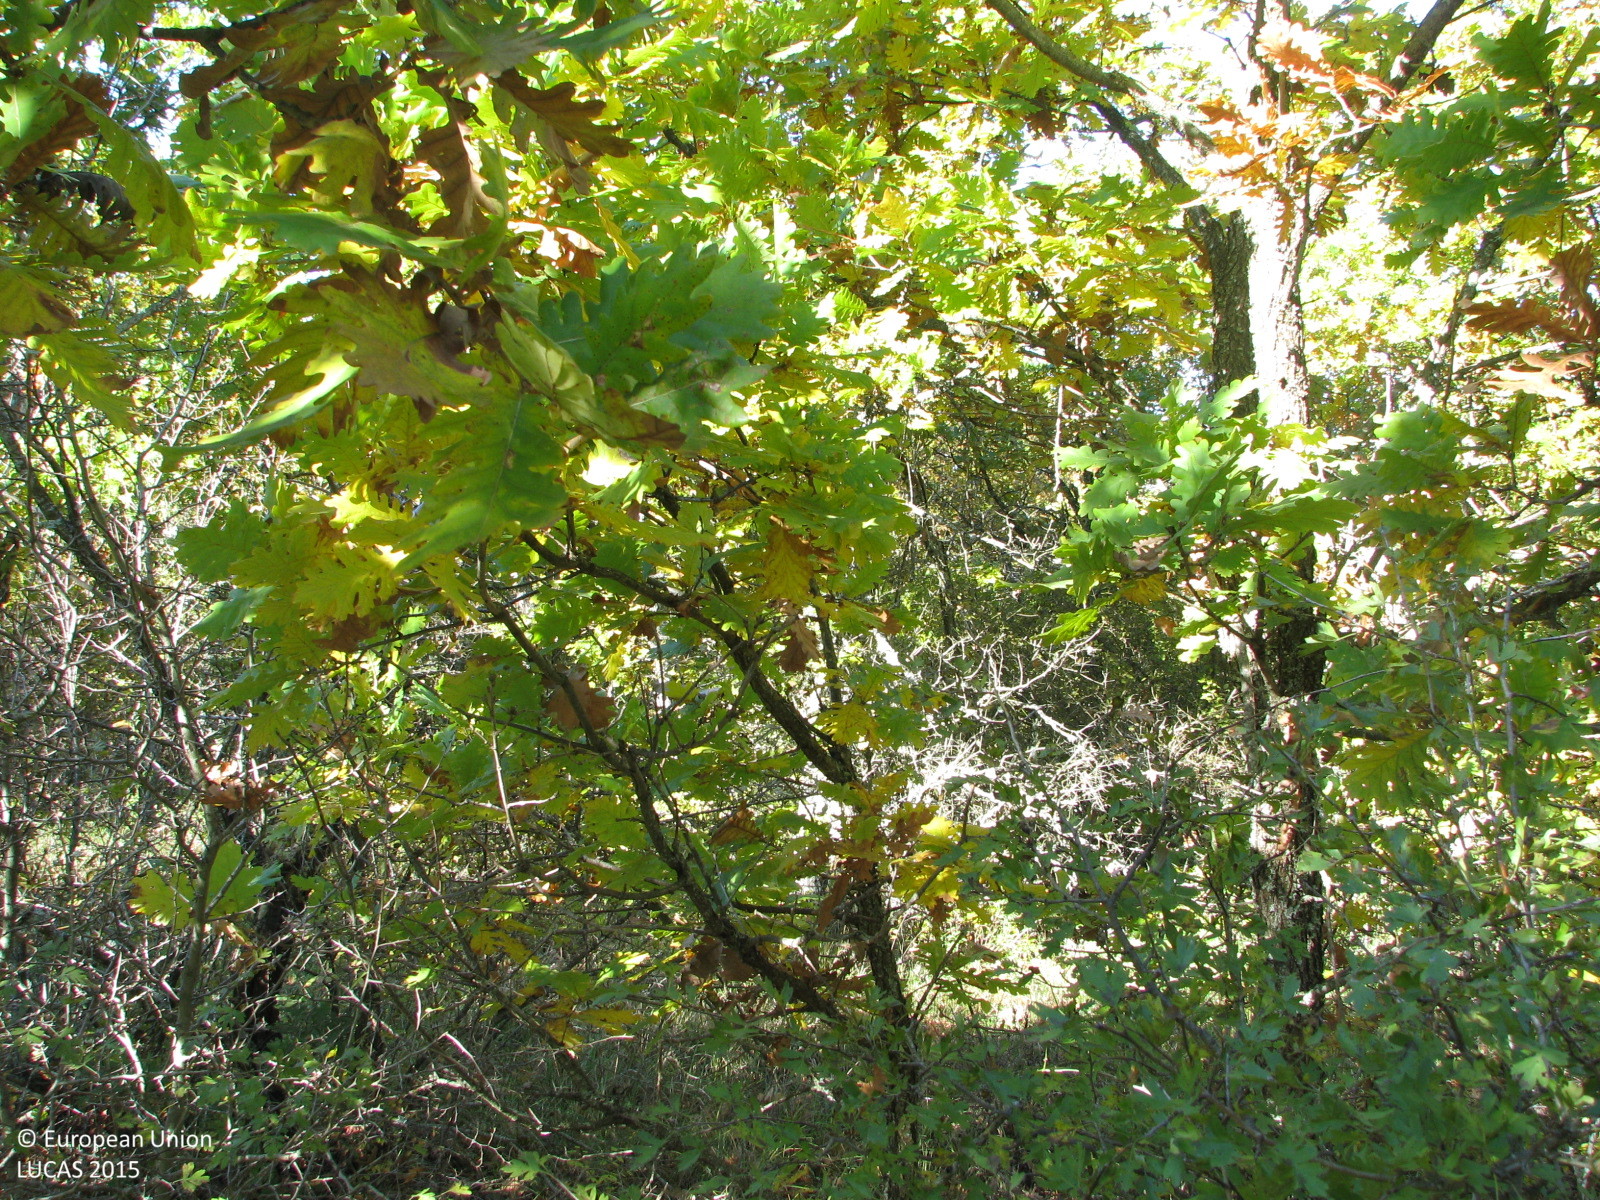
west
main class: Woodland
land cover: Broadleaved woodland
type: acidophilous oak and oak-birch forest
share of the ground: 50 - 75 %
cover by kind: broadleaved forest trees 60 %, herbaceous plants 30 %, shrubs 10 %
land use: Forestry
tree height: < 5 m
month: November
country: BG
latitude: 42.0196
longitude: 26.6463
